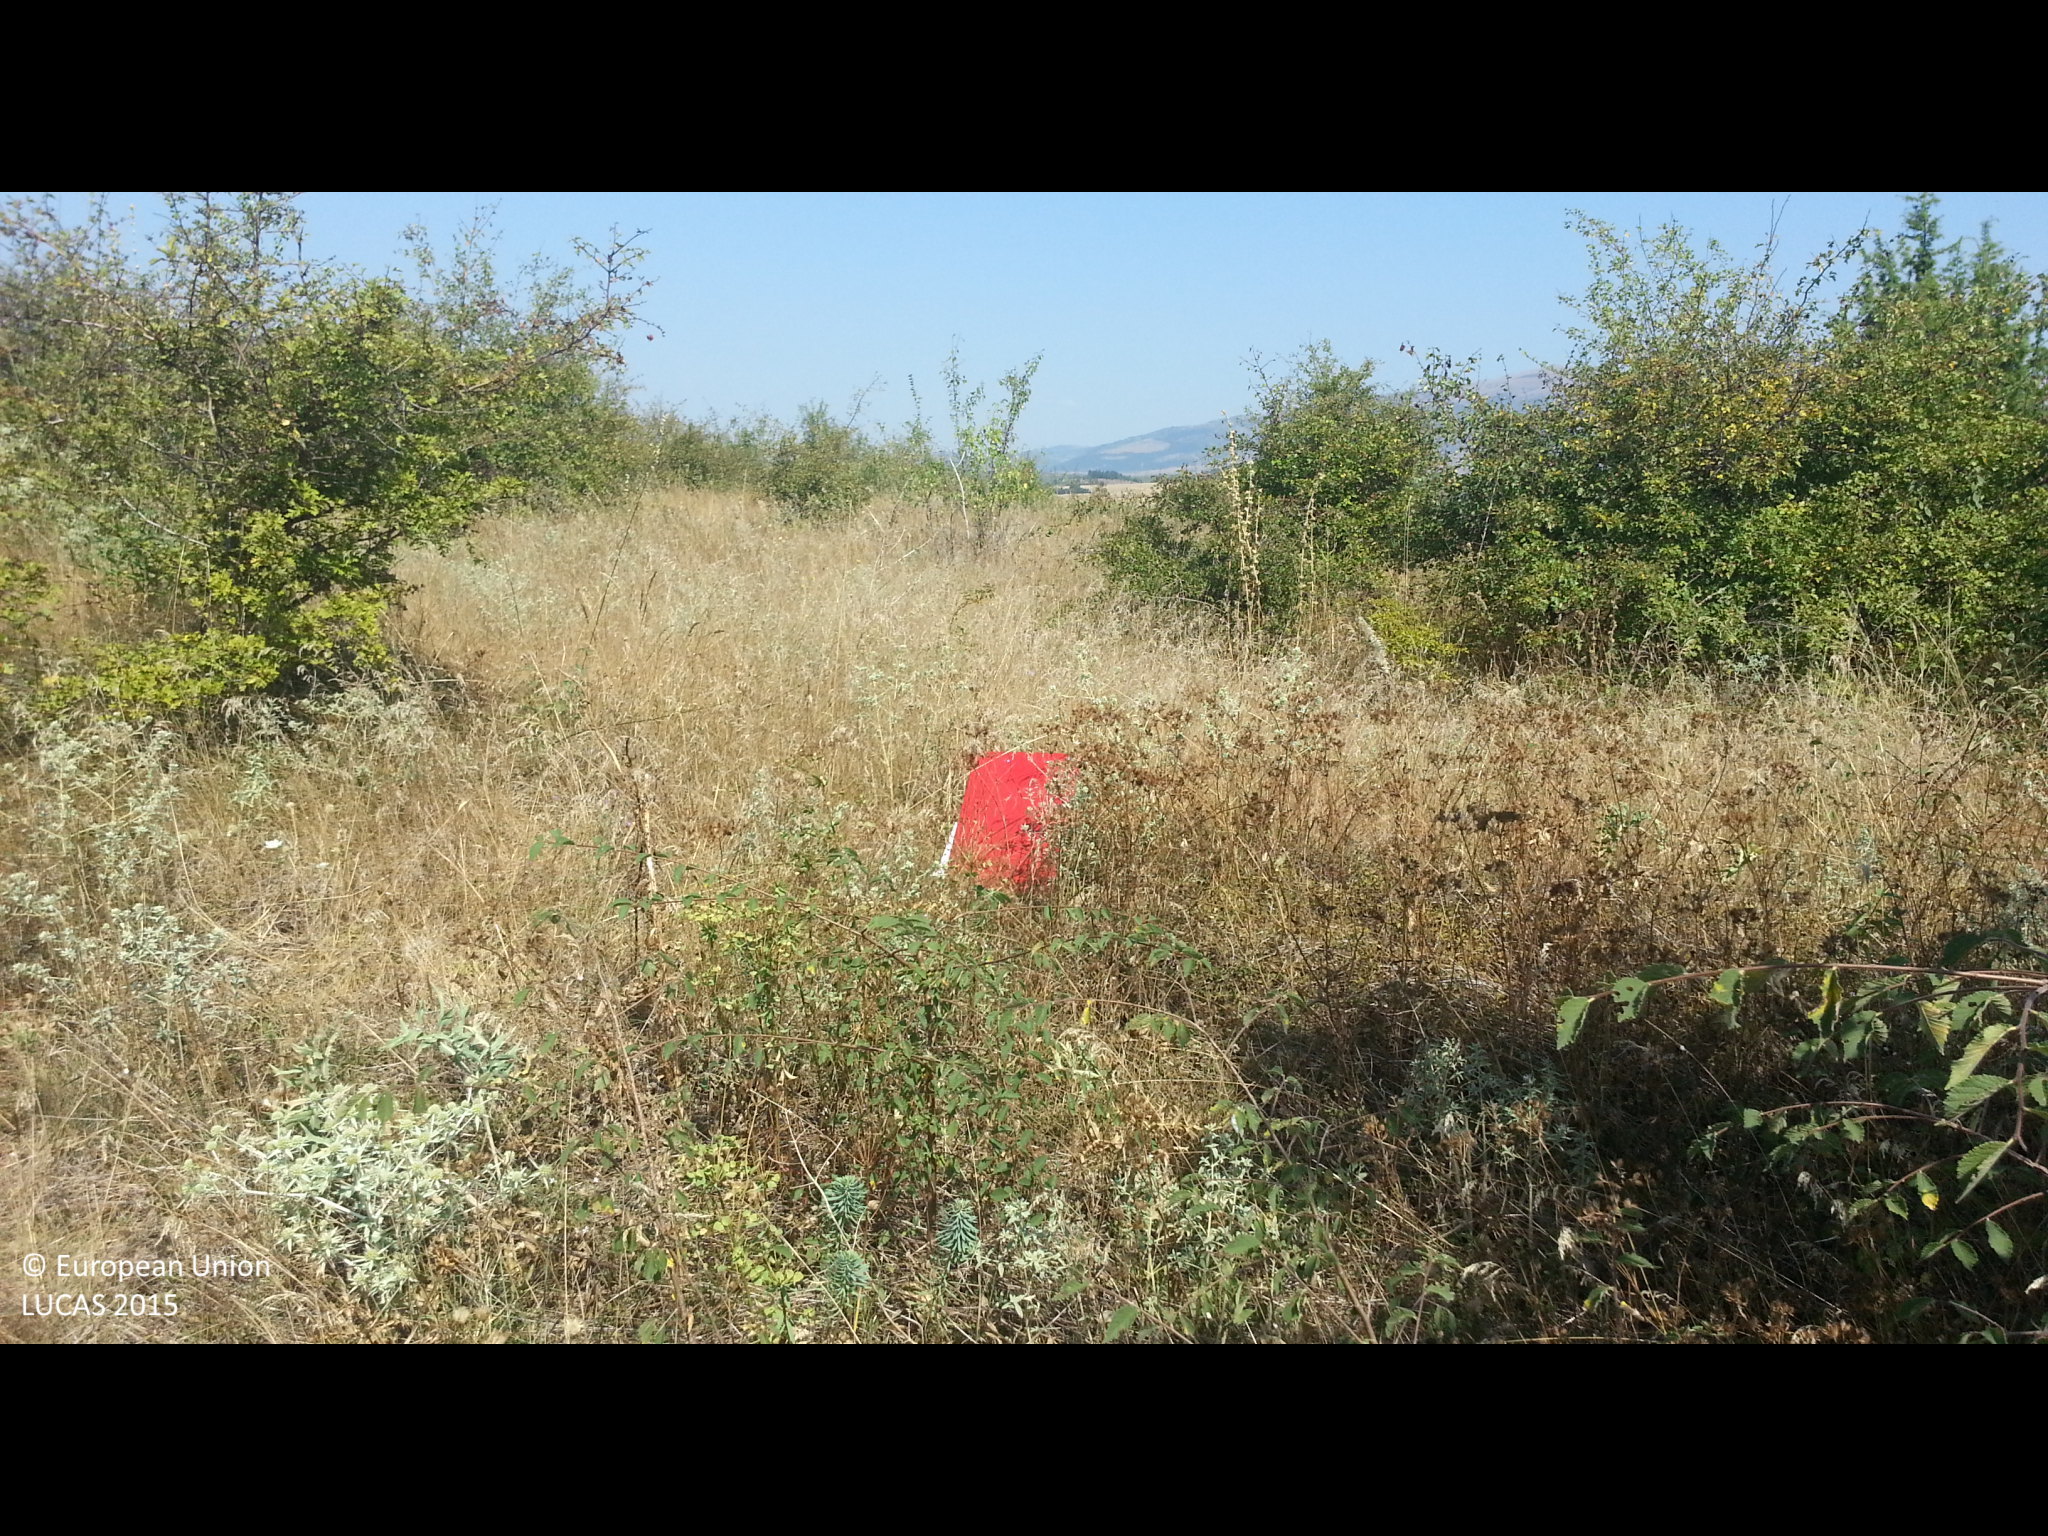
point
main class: Grassland
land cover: Grassland with sparse tree/shrub cover
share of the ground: > 75 %
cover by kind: herbaceous plants 85 %, shrubs 10 %, broadleaved forest trees 5 %
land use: Abandoned areas
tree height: < 5 m
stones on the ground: 10 - 25 %
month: August
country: BG
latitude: 42.2476
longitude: 22.8830
